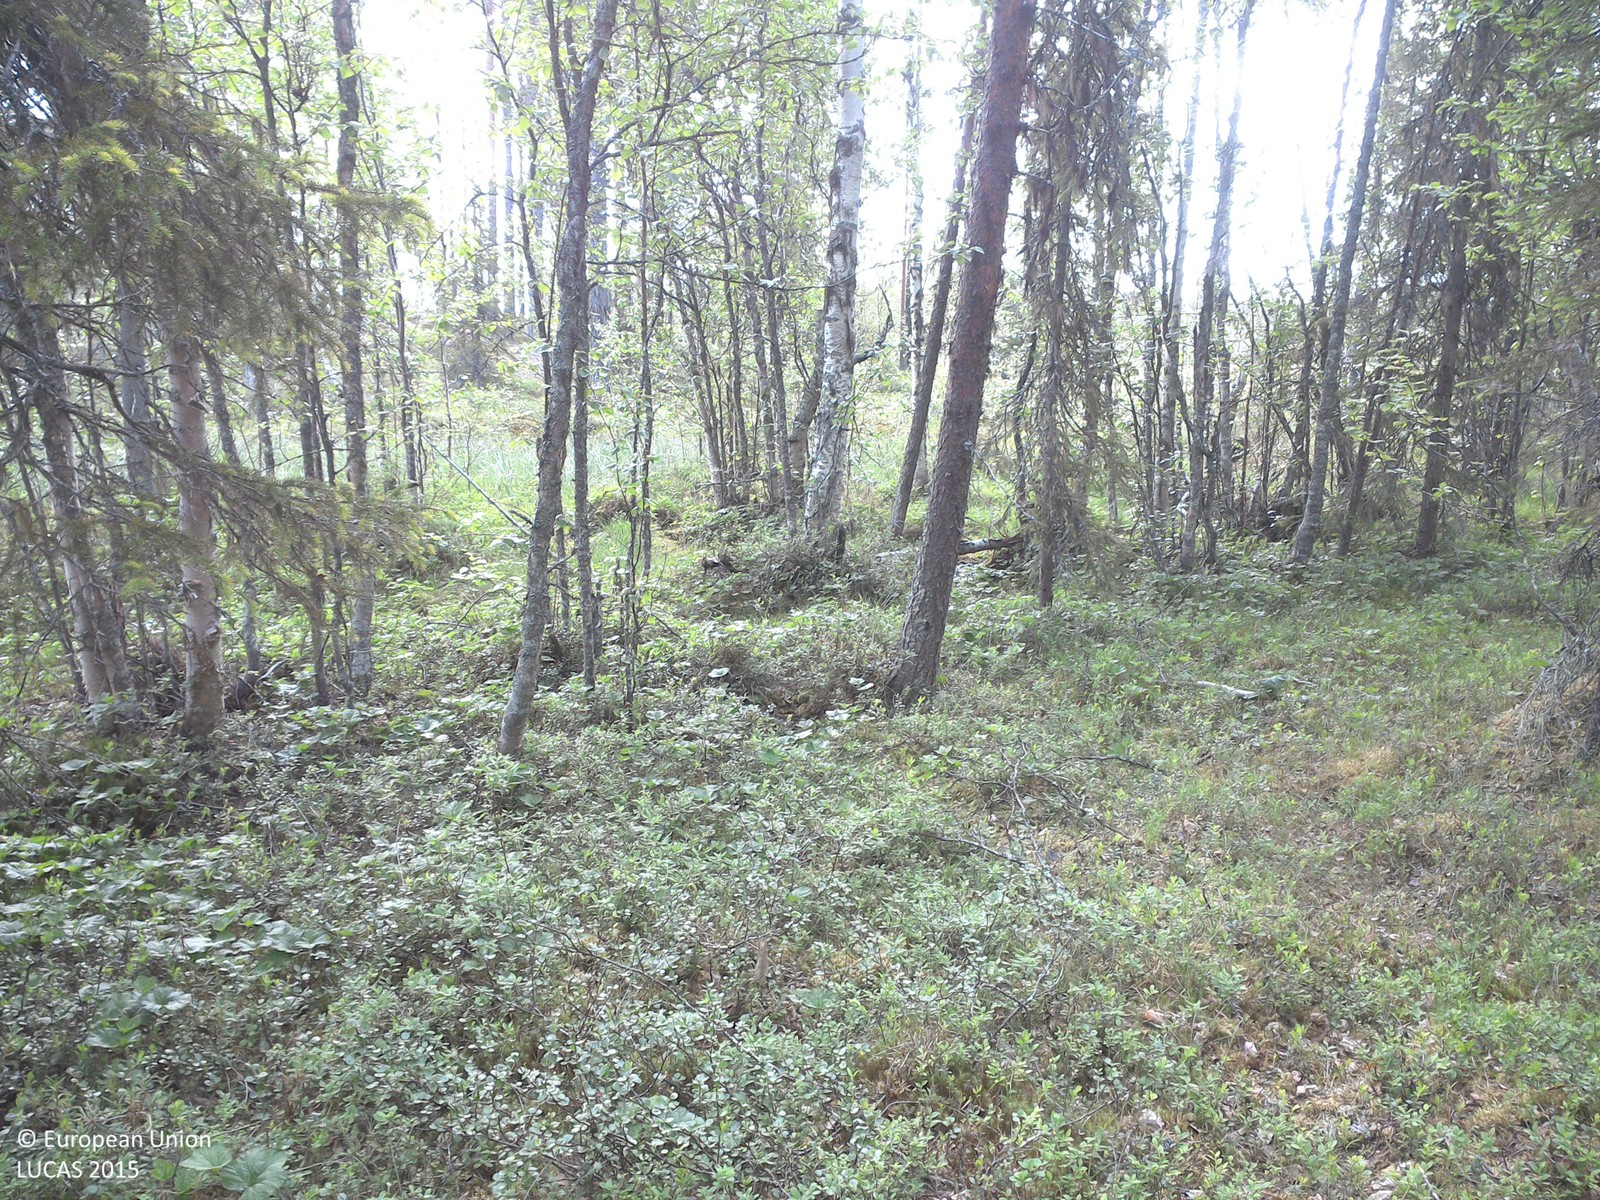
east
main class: Woodland
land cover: Pine dominated mixed woodland
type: boreal forest
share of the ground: 25 - 50 %
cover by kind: shrubs 50 %, coniferous forest trees 20 %, lichens and mosses 20 %, broadleaved forest trees 10 %
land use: Forestry
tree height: > 5 m
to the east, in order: Pine dominated mixed woodland; Groves; Pine dominated coniferous woodland; Peatbogs; Pine dominated coniferous woodland; Peatbogs
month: July
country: SE
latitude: 67.3619
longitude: 22.6496
